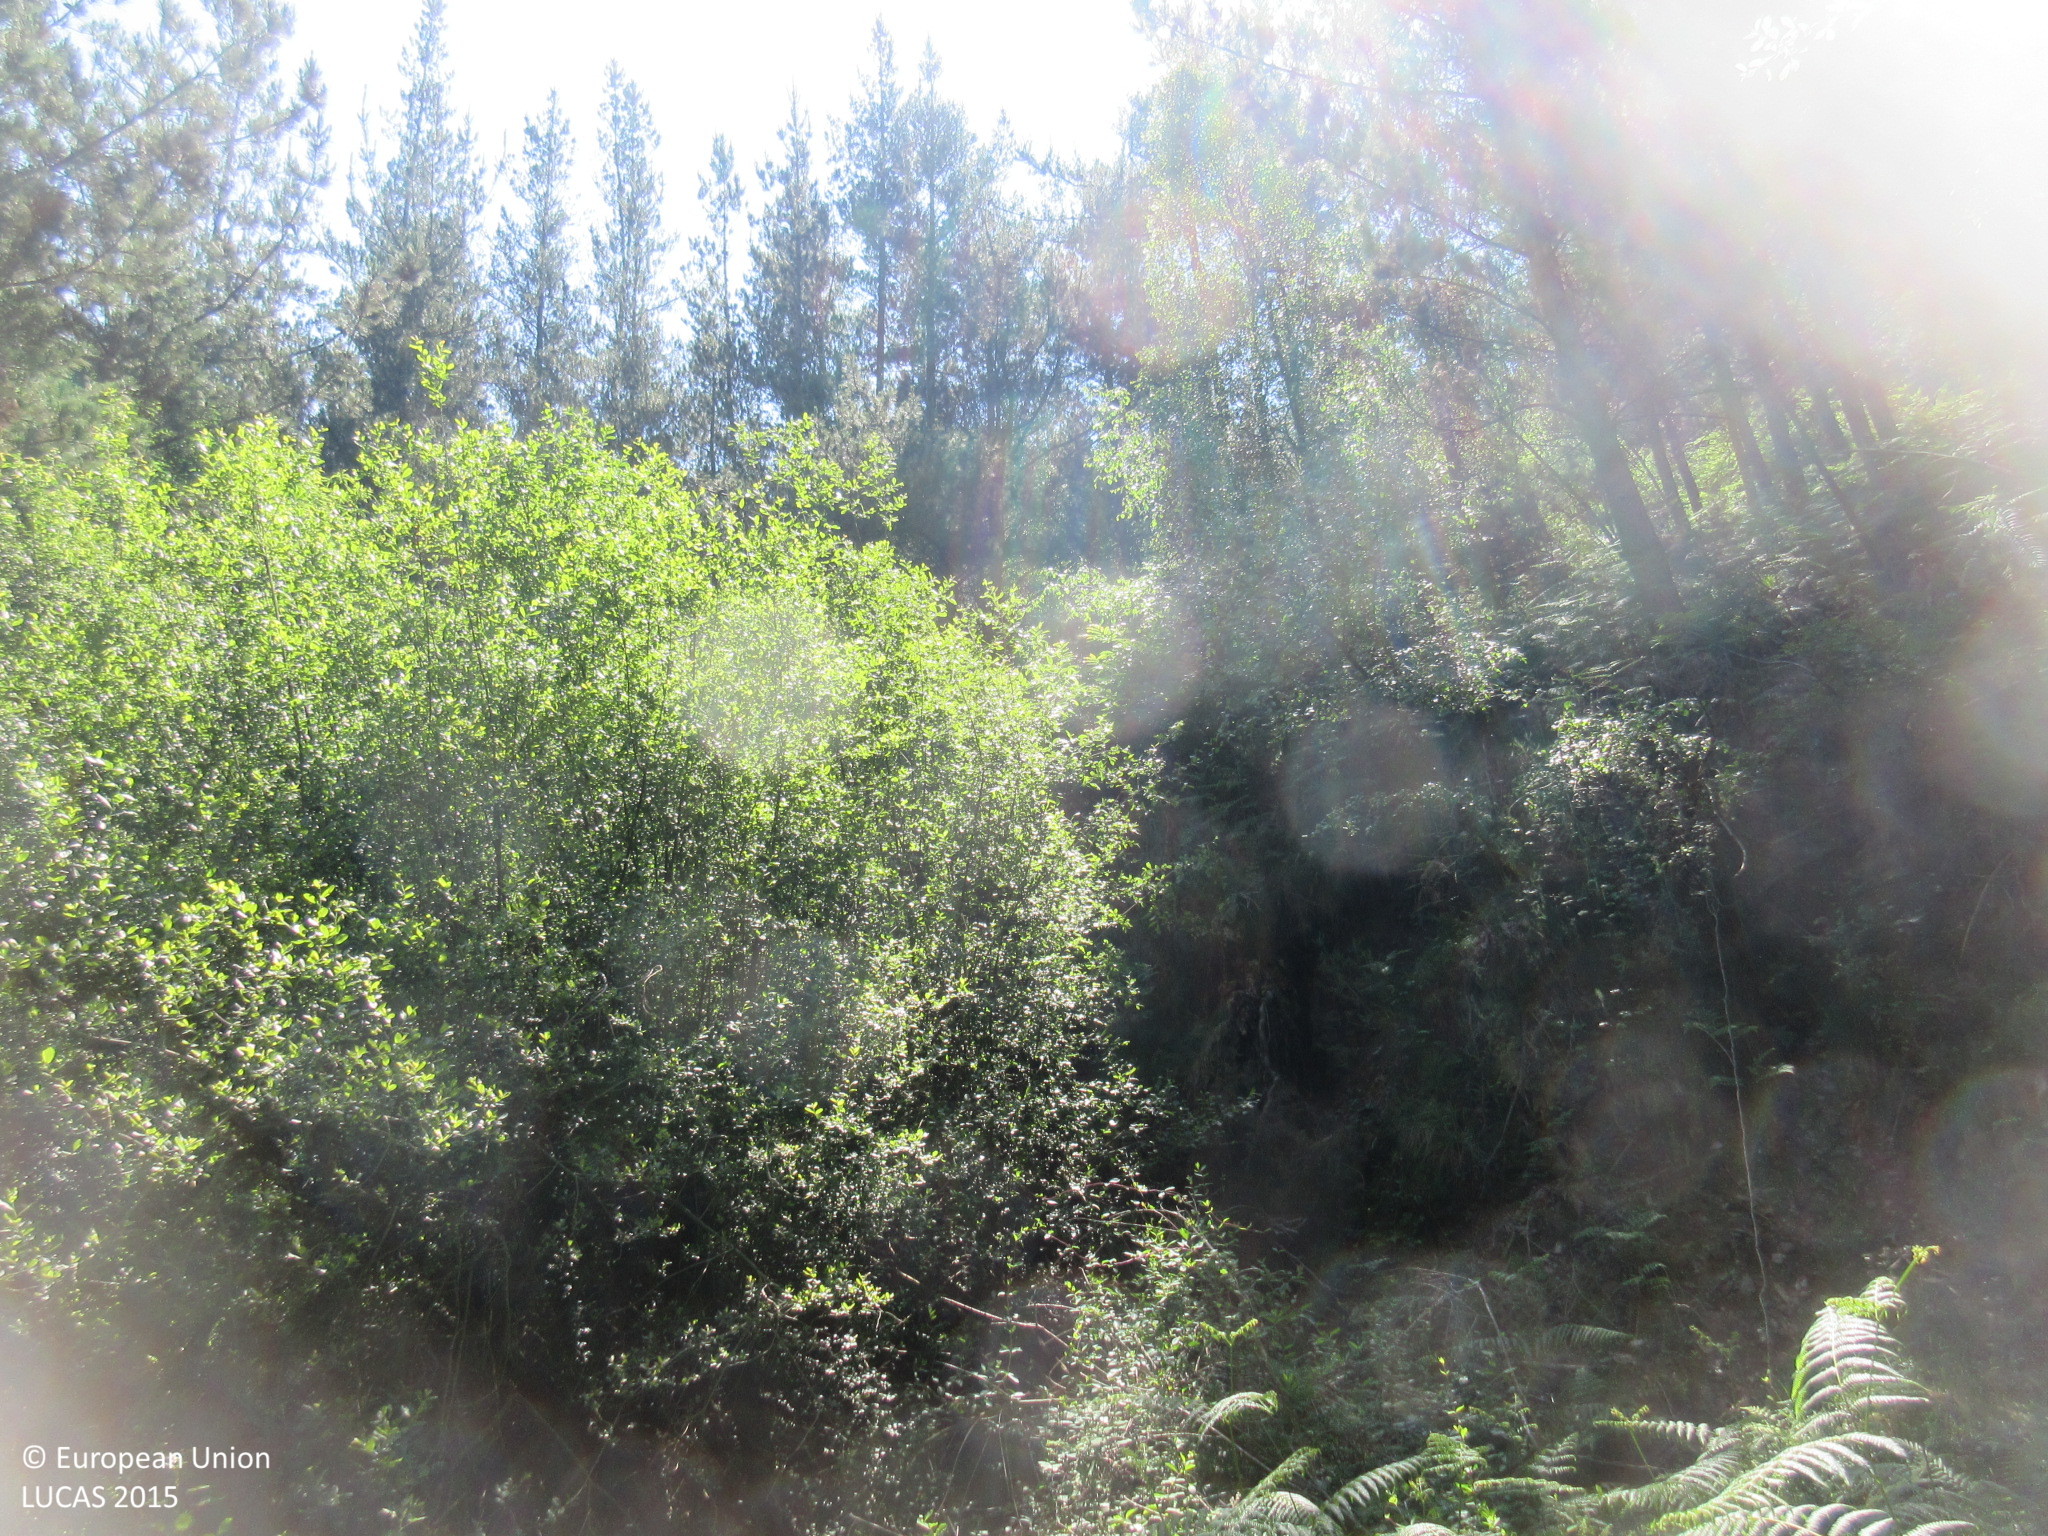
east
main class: Woodland
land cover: Broadleaved woodland
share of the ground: > 75 %
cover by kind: broadleaved forest trees 90 %, shrubs 10 %
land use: Forestry
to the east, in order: Broadleaved woodland; Tracks; Pine dominated coniferous woodland; Tracks; Pine dominated coniferous woodland
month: June
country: ES
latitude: 43.4665
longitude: -6.0005
